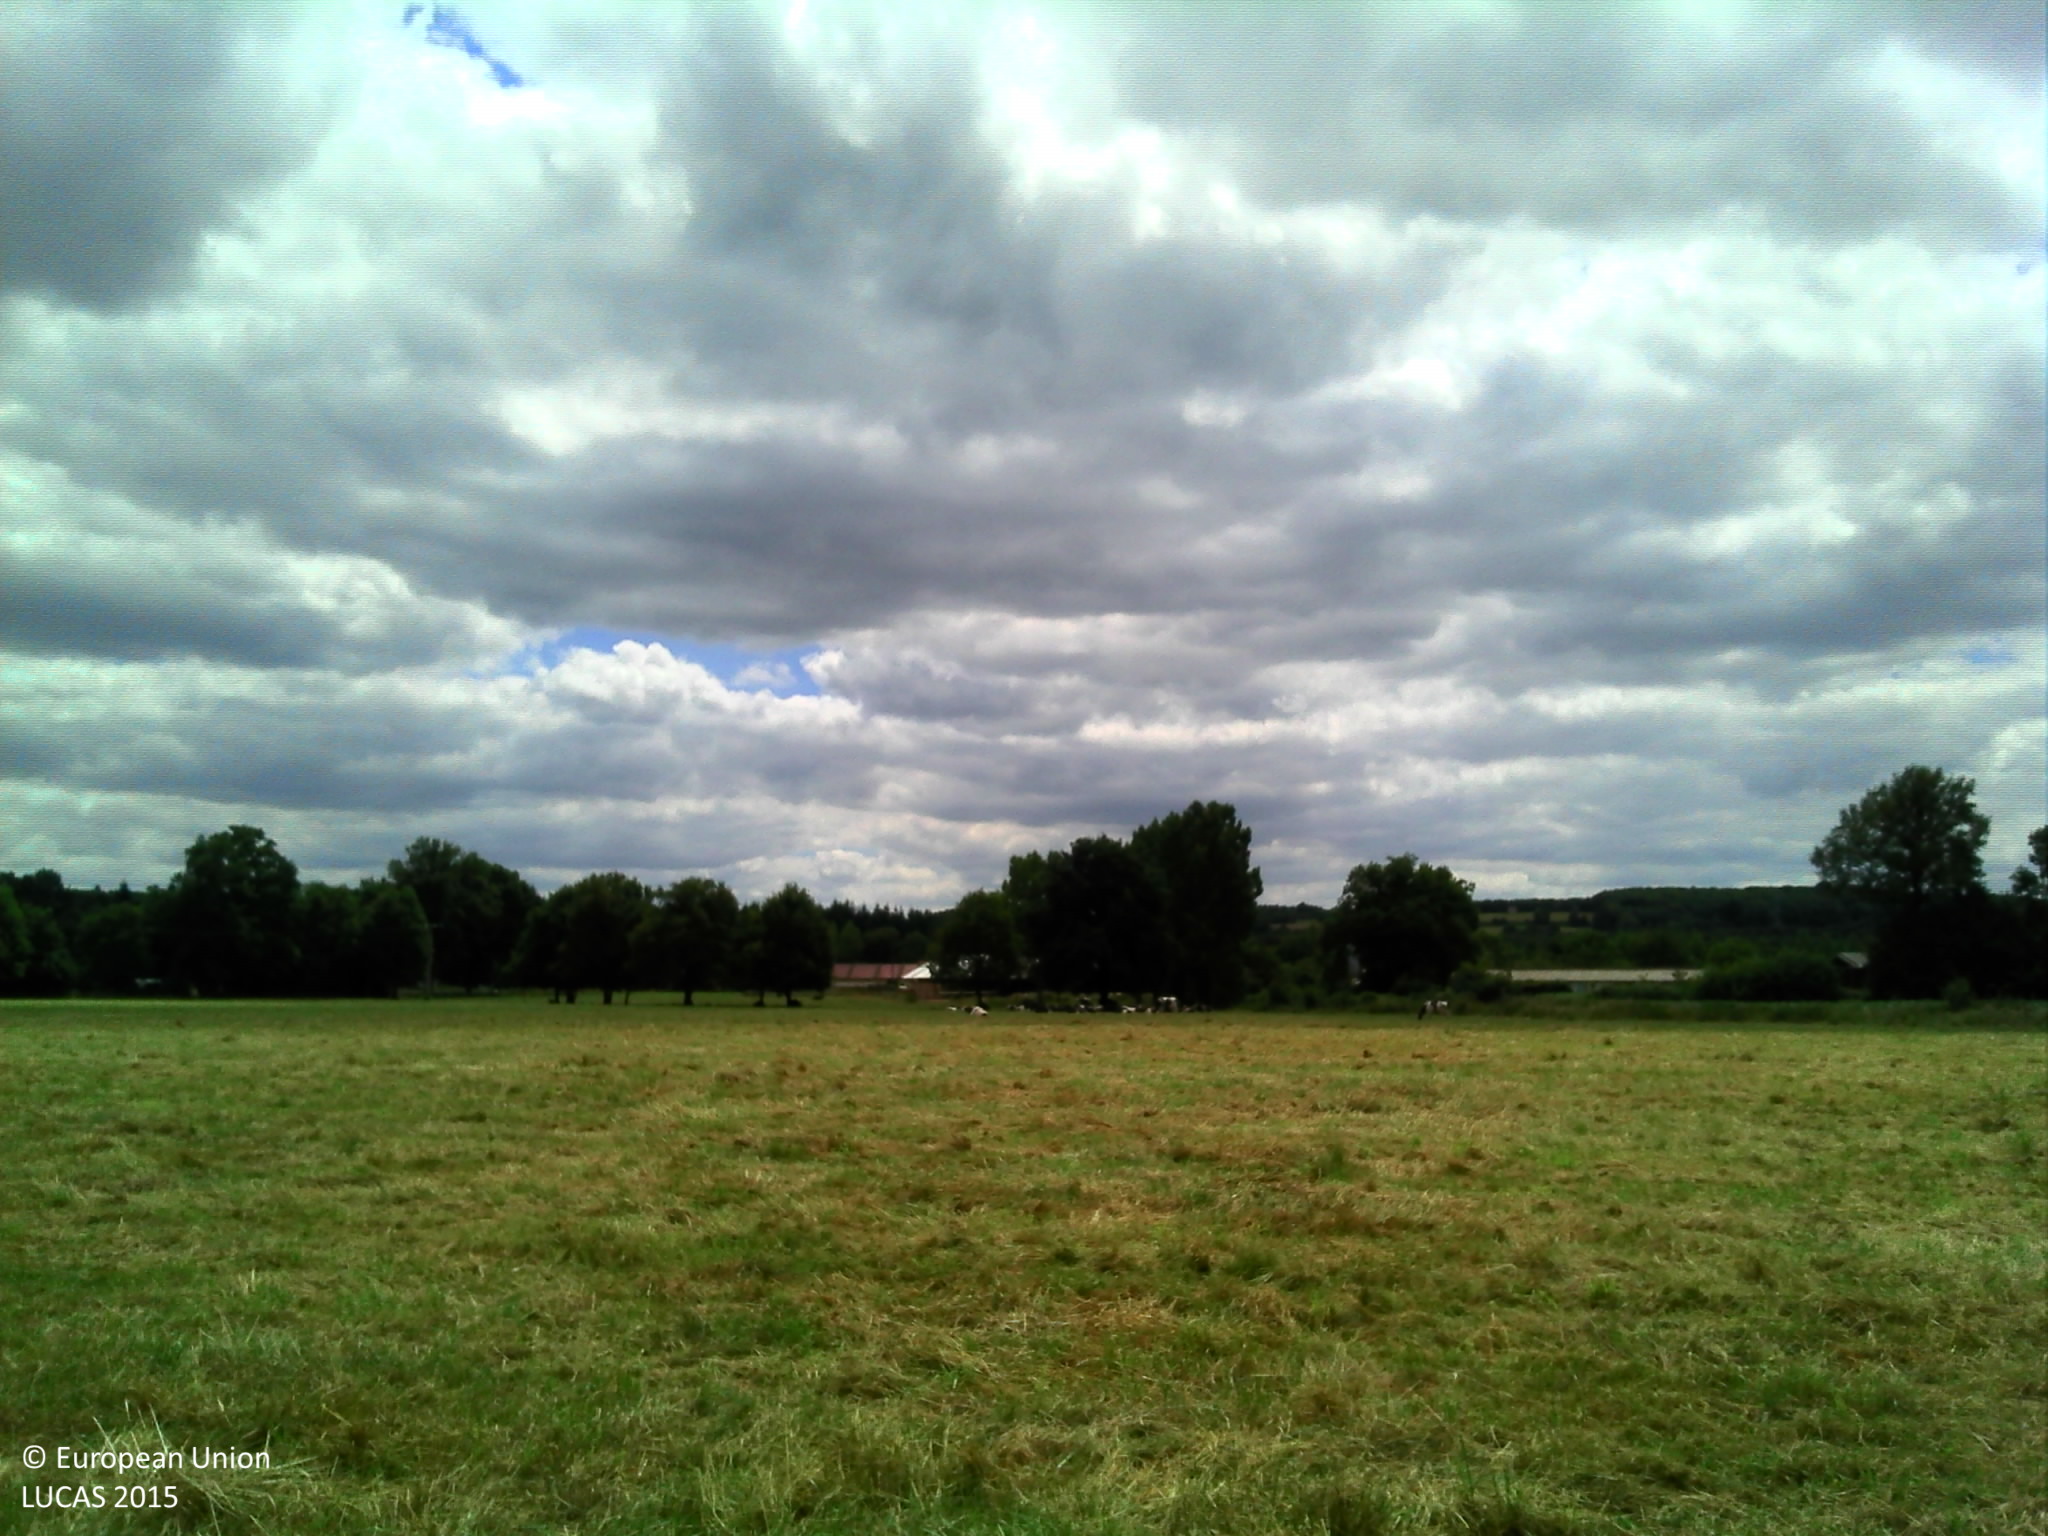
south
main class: Grassland
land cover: Grassland without tree/shrub cover
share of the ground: > 75 %
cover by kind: herbaceous plants 100 %
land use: Agriculture (excluding fallow land and kitchen gardens)
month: June
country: FR
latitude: 47.8682
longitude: 0.3099
